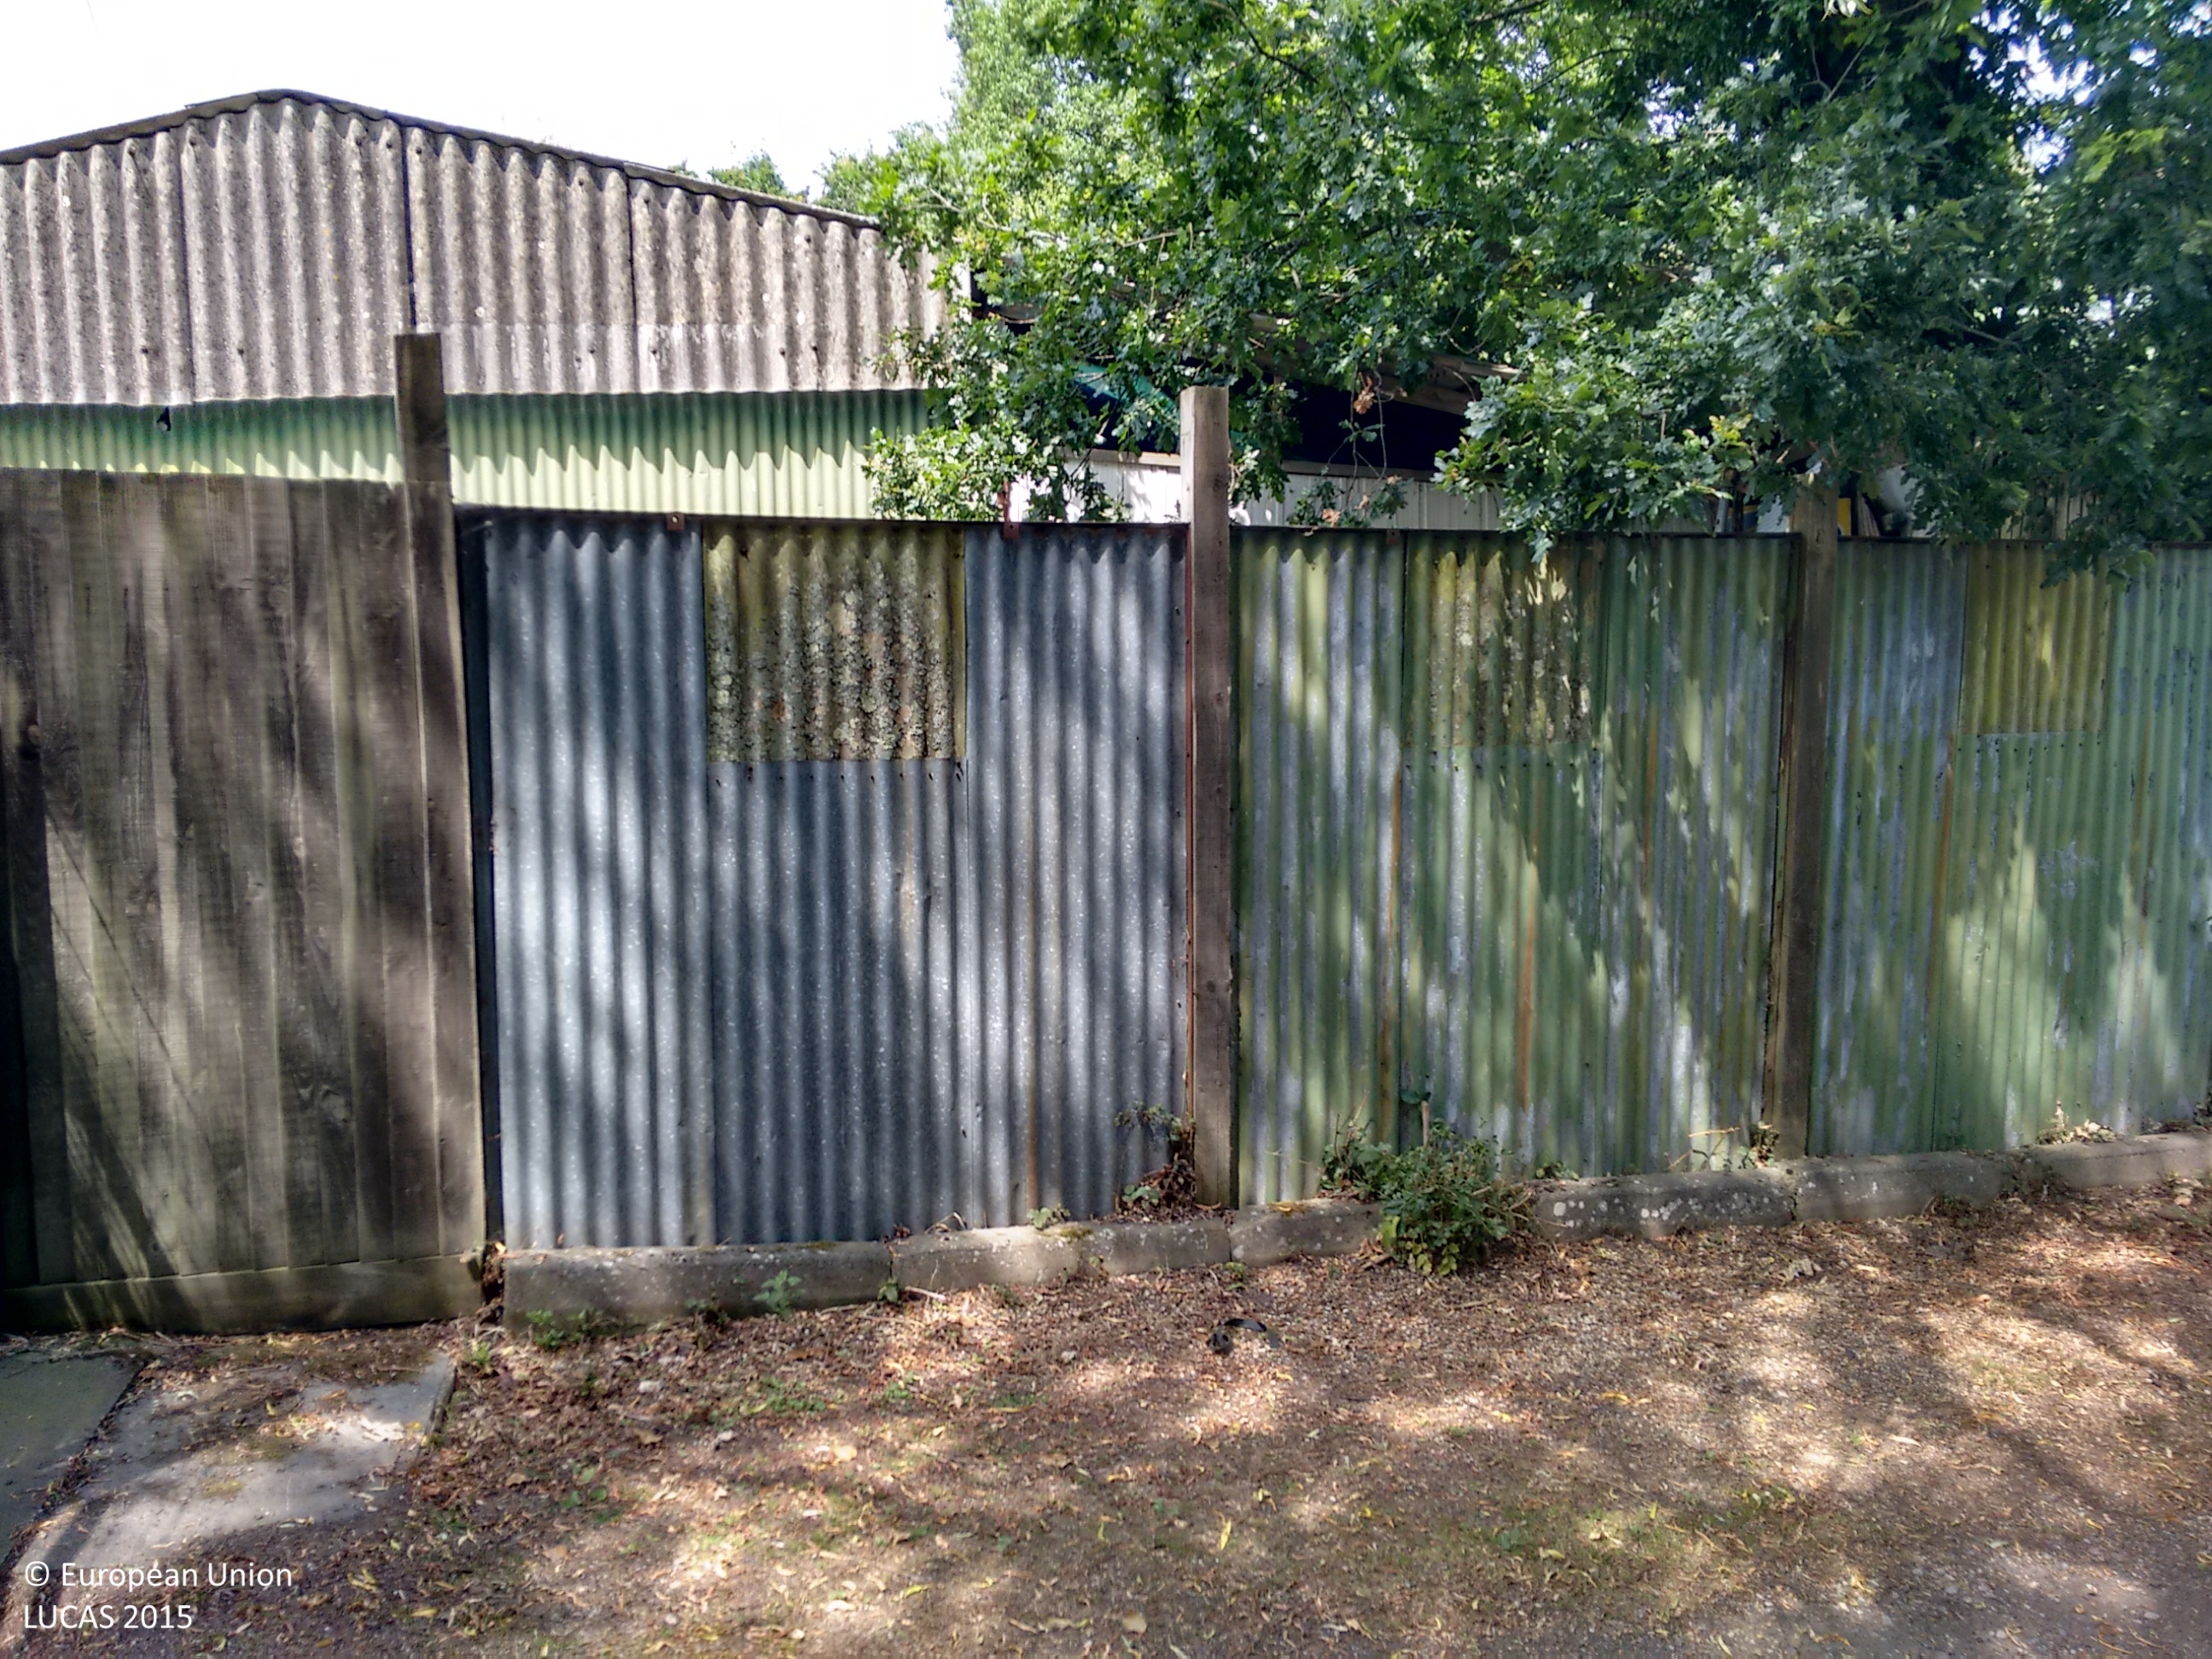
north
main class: Woodland
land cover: Broadleaved woodland
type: mesophytic deciduous forest
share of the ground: > 75 %
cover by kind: broadleaved forest trees 100 %
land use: Semi-natural and natural areas not in use
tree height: > 5 m
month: July
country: GB
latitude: 50.9570
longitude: -0.4157
